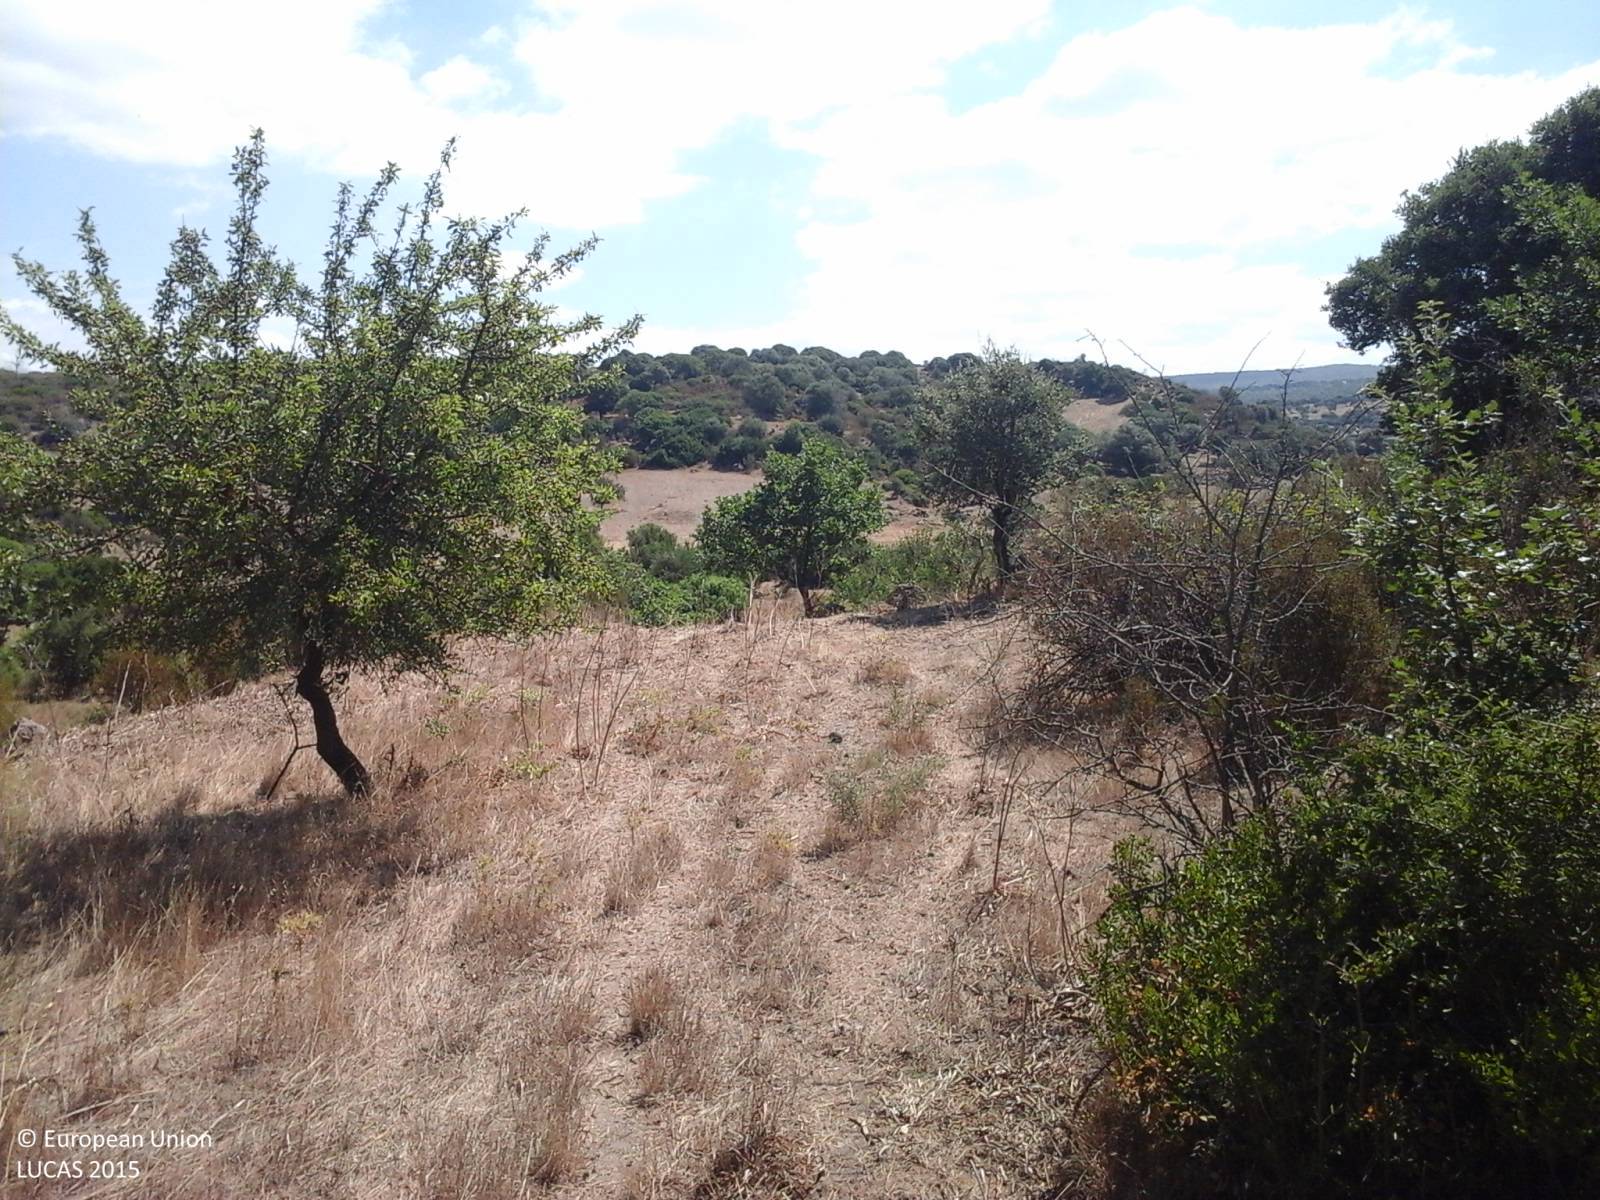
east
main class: Grassland
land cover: Grassland with sparse tree/shrub cover
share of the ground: 25 - 50 %
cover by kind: herbaceous plants 85 %, shrubs 10 %, broadleaved forest trees 5 %
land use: Agriculture (excluding fallow land and kitchen gardens)
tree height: < 5 m
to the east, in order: Grassland with sparse tree/shrub cover; Grassland without tree/shrub cover; Grassland with sparse tree/shrub cover; Dry stone walls; Fences; Other bare soil; Fences; Tracks; Grassland without tree/shrub cover; Single bushes/trees; Grassland without tree/shrub cover; Shrubland with sparse tree cover
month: July
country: IT
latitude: 40.5144
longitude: 8.8844
